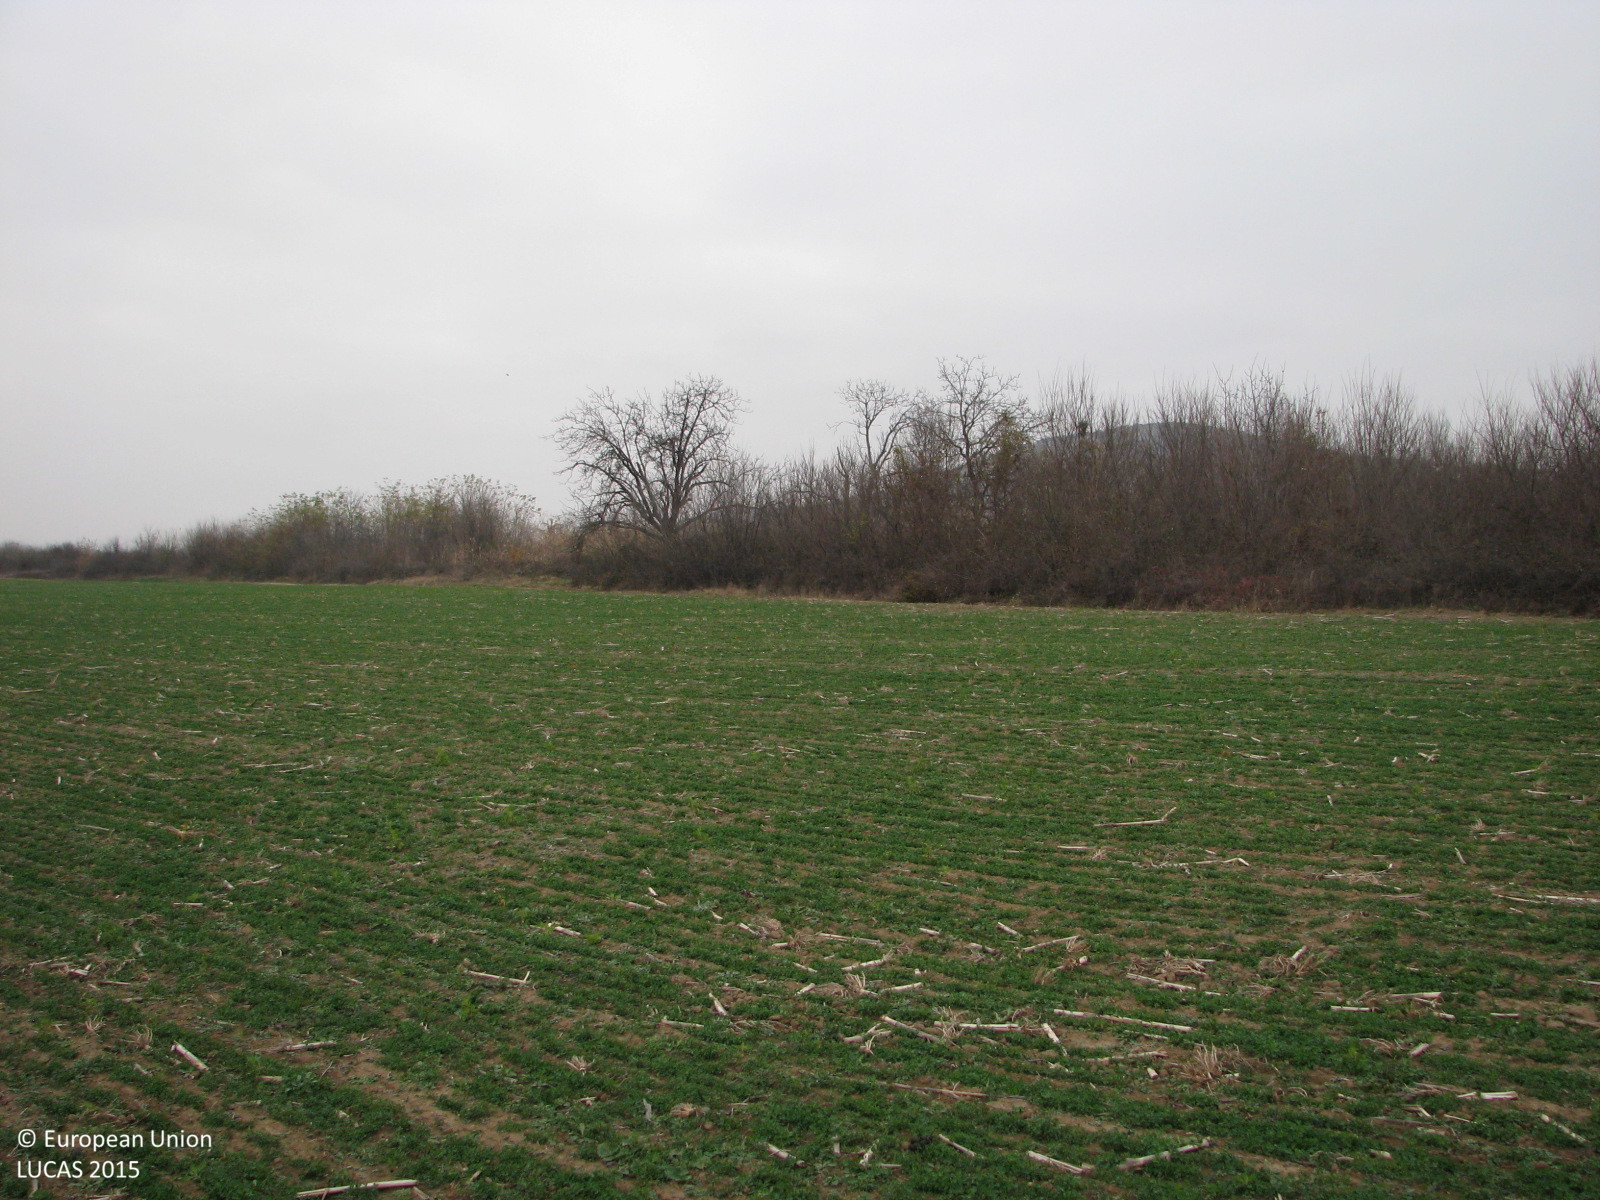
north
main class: Cropland
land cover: Maize
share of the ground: < 10 %
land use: Agriculture (excluding fallow land and kitchen gardens)
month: December
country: BG
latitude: 42.2325
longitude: 24.2079
